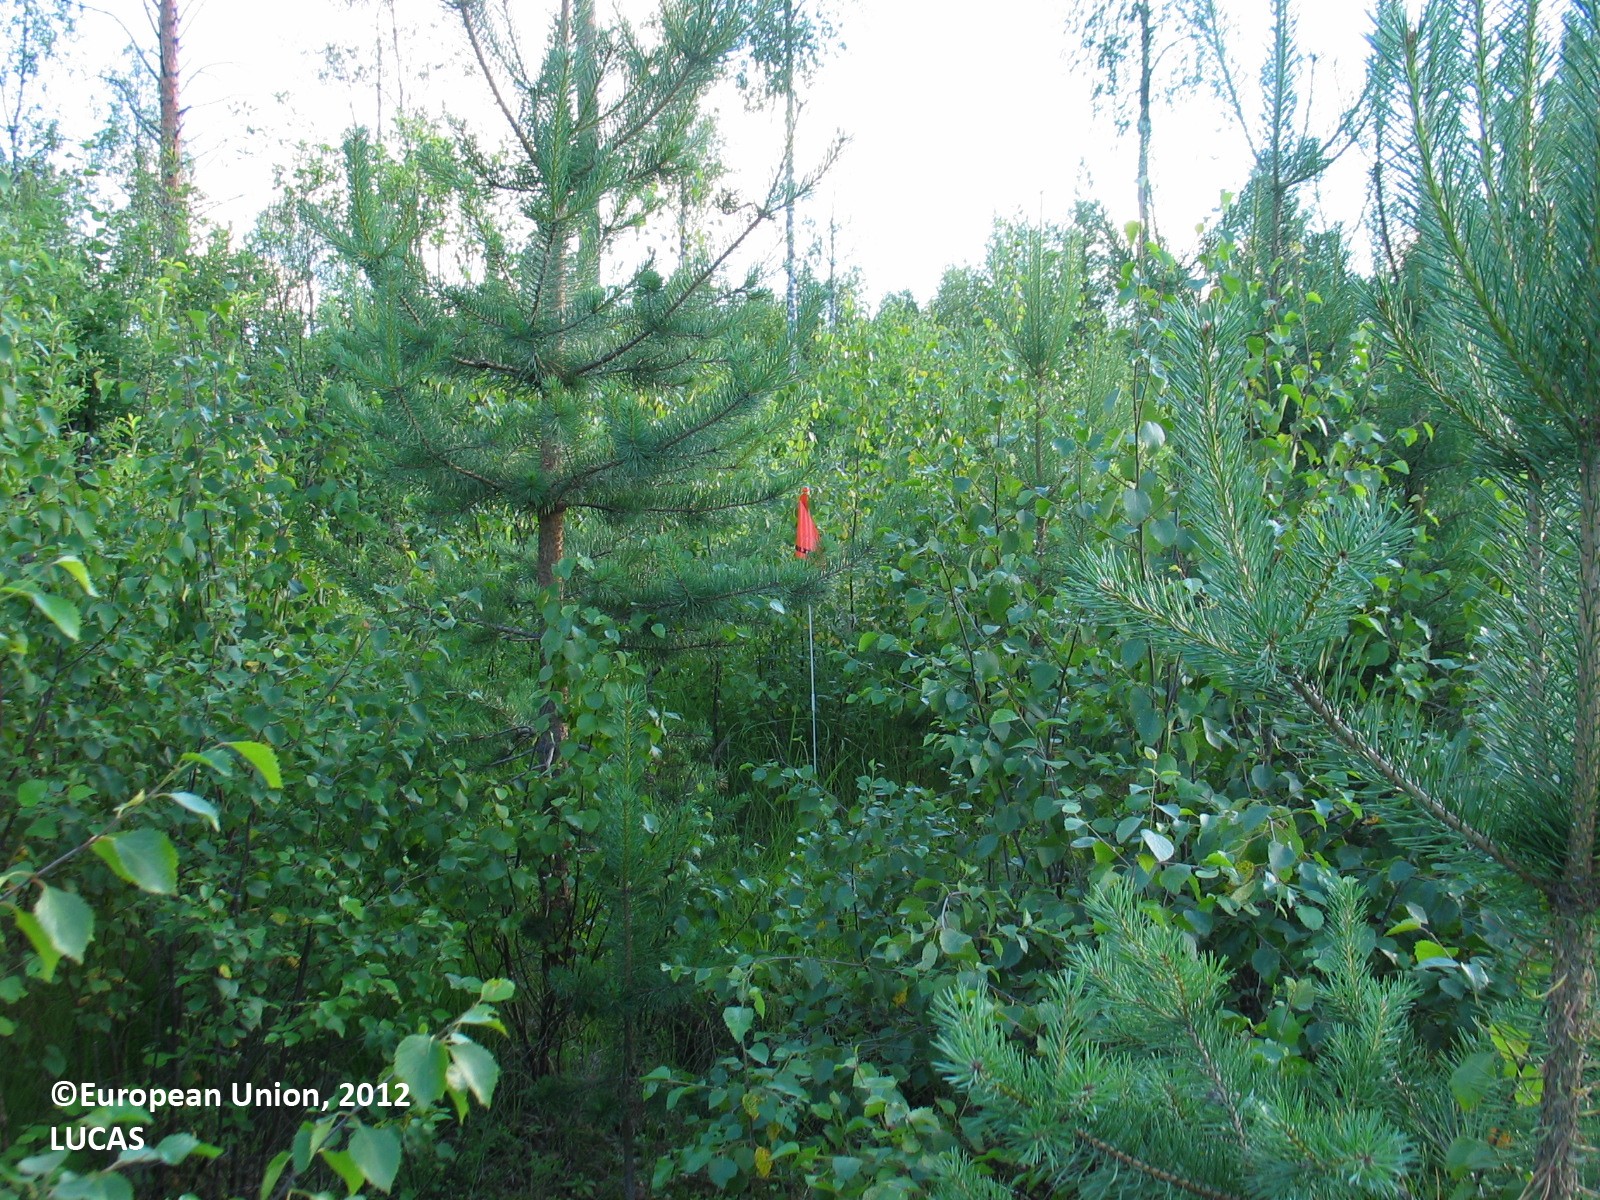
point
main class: Woodland
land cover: Pine dominated mixed woodland
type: boreal forest
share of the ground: 50 - 75 %
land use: Forestry
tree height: < 5 m
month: July
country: FI
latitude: 64.6384
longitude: 26.4964
